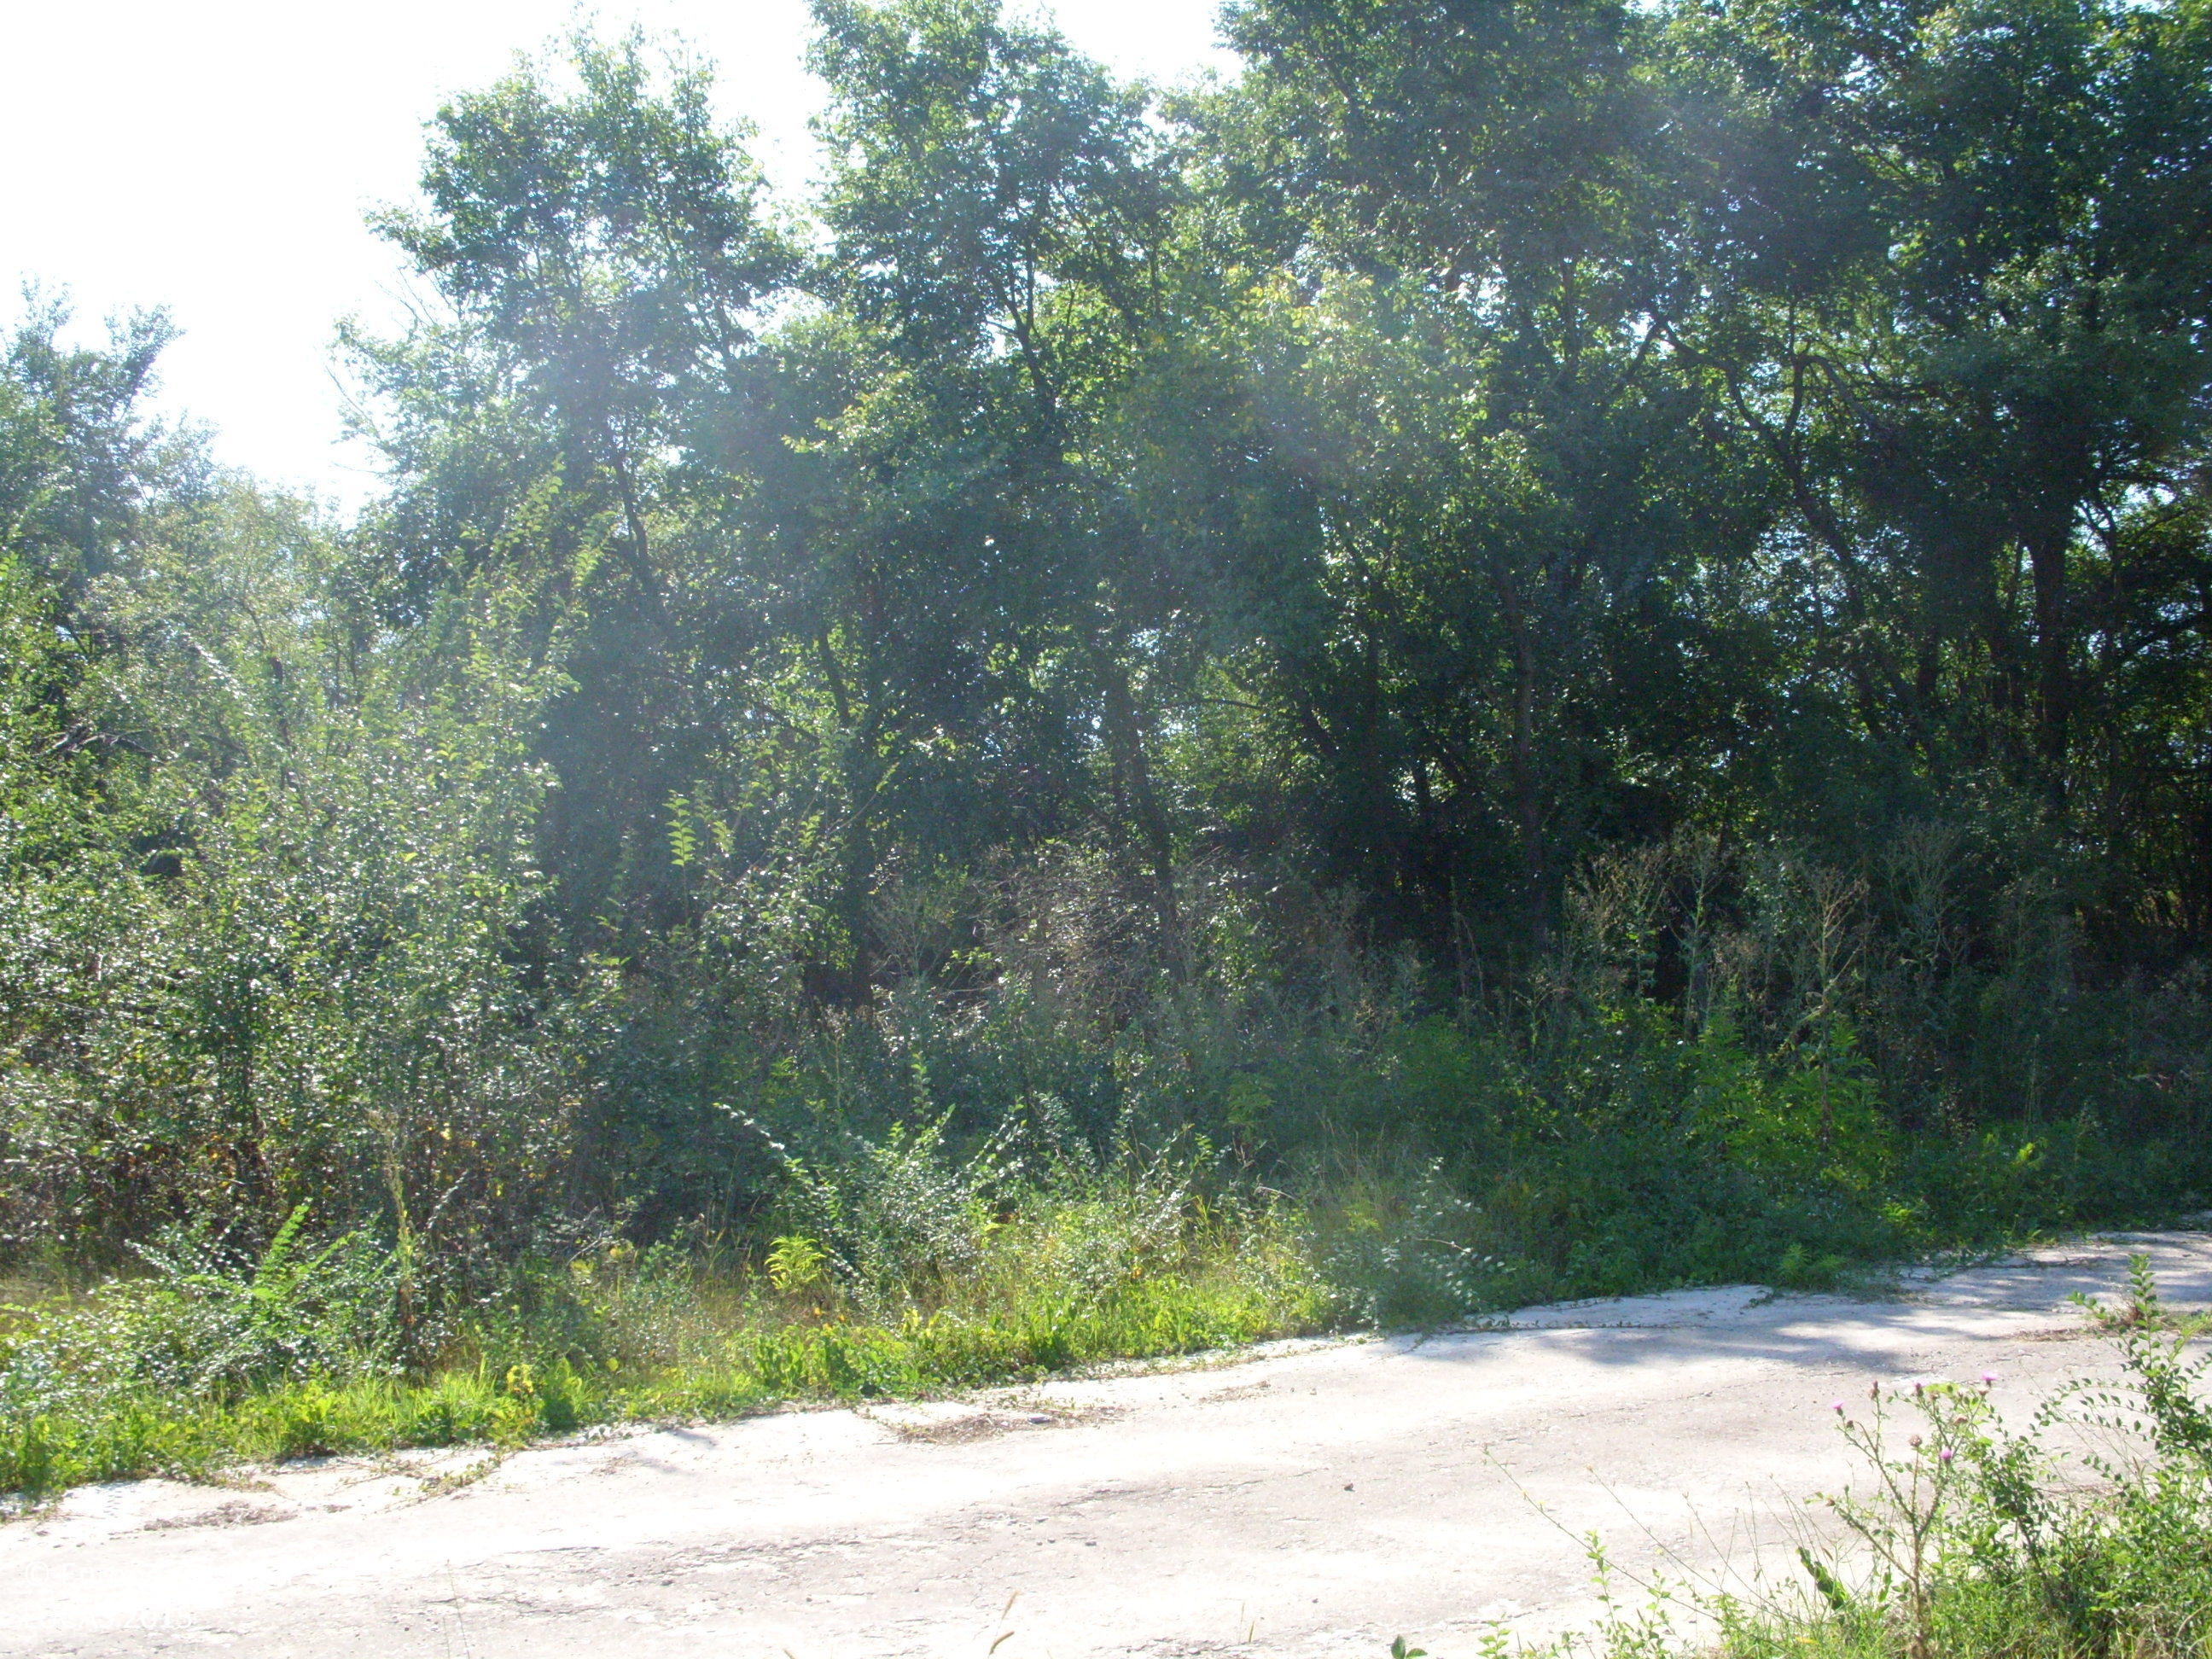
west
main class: Grassland
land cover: Grassland with sparse tree/shrub cover
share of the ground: > 75 %
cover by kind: herbaceous plants 90 %, broadleaved forest trees 5 %, shrubs 5 %
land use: Water supply and treatment
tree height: < 5 m
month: August
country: BG
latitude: 42.3788
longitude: 25.0839
